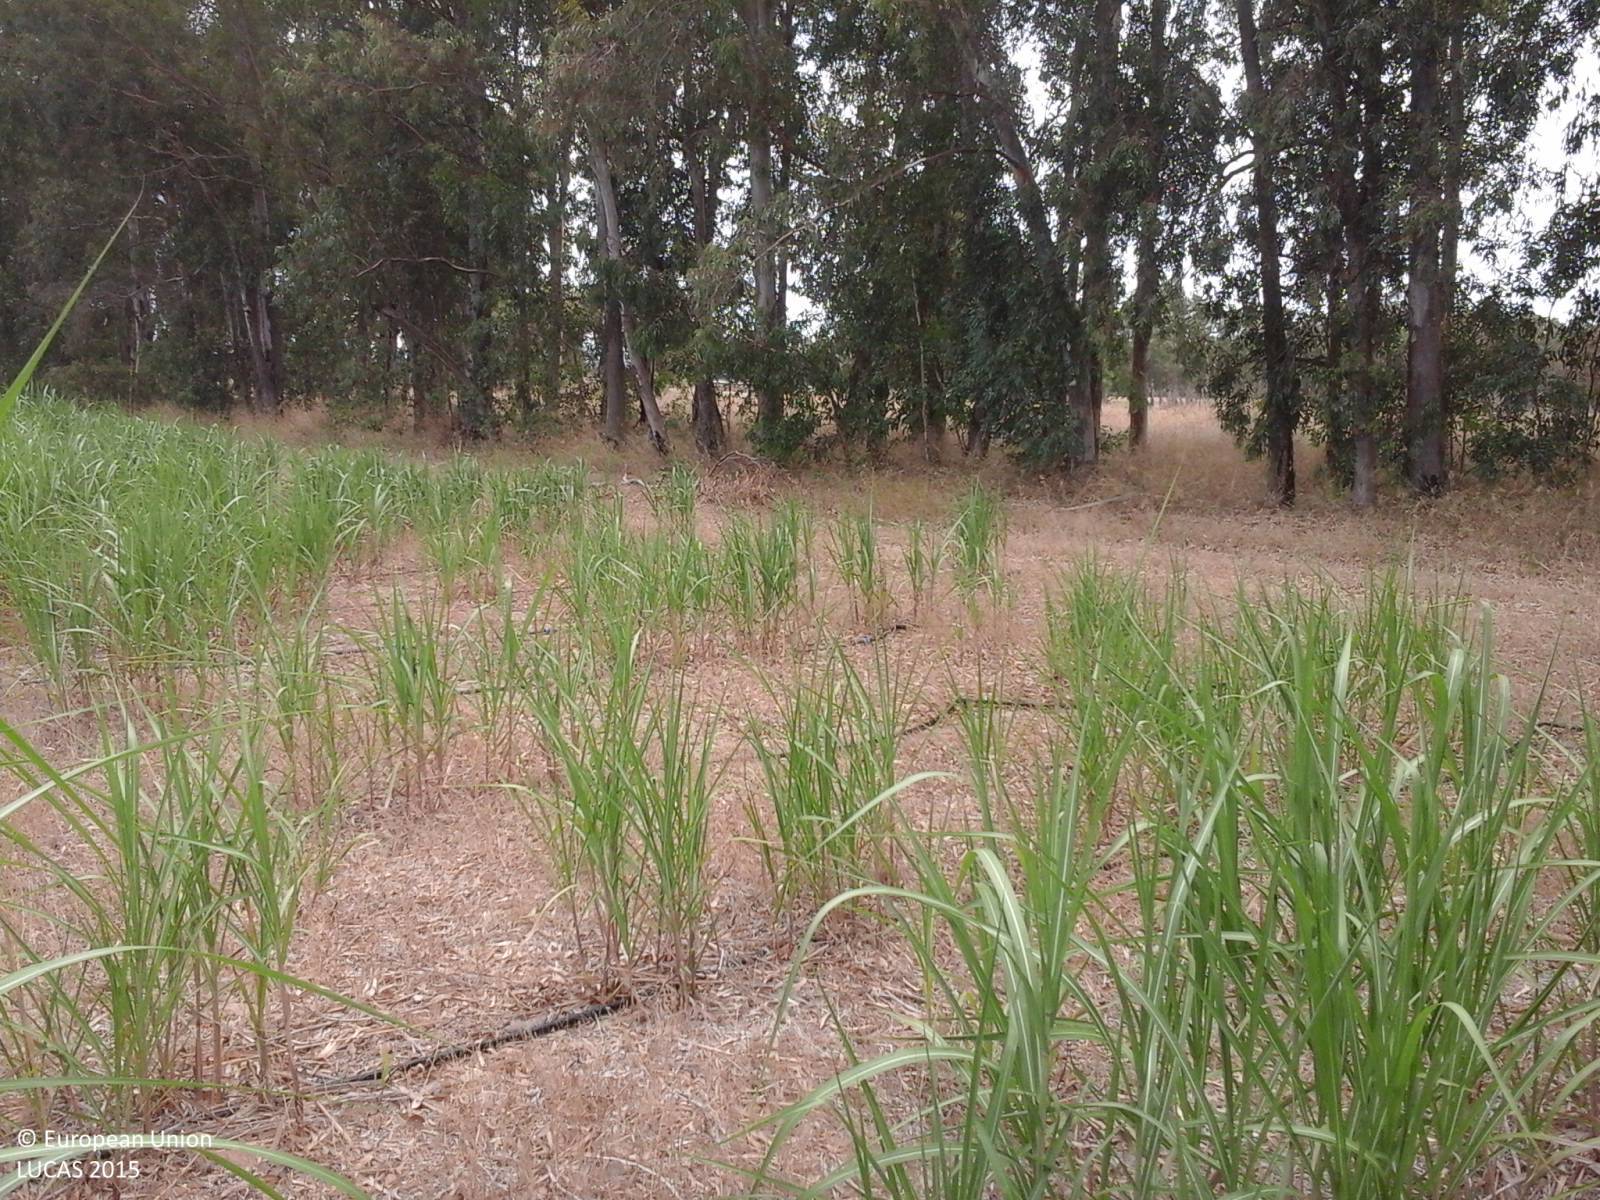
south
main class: Cropland
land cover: Permanent industrial crops
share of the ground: > 75 %
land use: Agriculture (excluding fallow land and kitchen gardens)
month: July
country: IT
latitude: 39.4638
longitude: 8.8562
